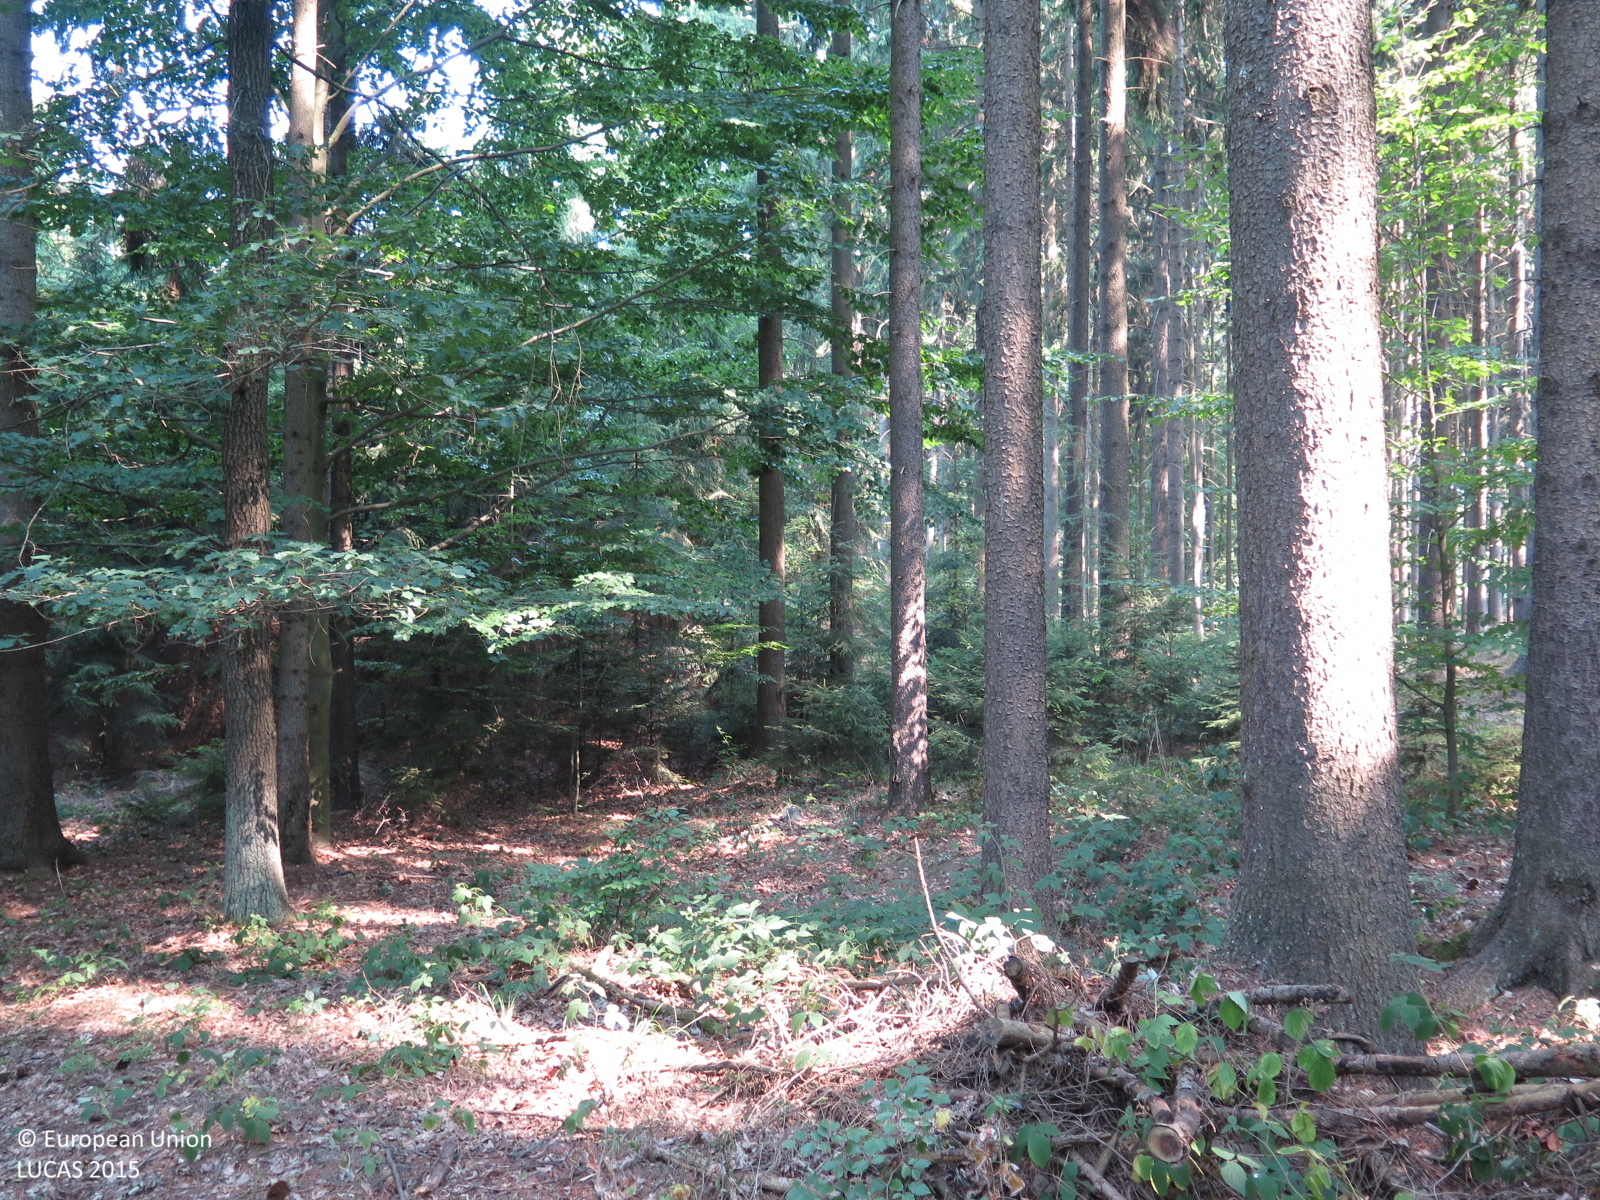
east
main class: Woodland
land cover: Spruce dominated mixed woodland
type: hemiboreal forest and nemoral coniferous forest and mixed broadleaved-coniferous forest
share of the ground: > 75 %
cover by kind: coniferous forest trees 65 %, broadleaved forest trees 30 %, herbaceous plants 5 %
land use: Forestry
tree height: > 5 m
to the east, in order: Spruce dominated mixed woodland; Spruce dominated coniferous woodland; Tracks; Spruce dominated mixed woodland; Broadleaved woodland; Spruce dominated coniferous woodland
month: August
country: CZ
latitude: 49.8860
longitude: 13.8281
